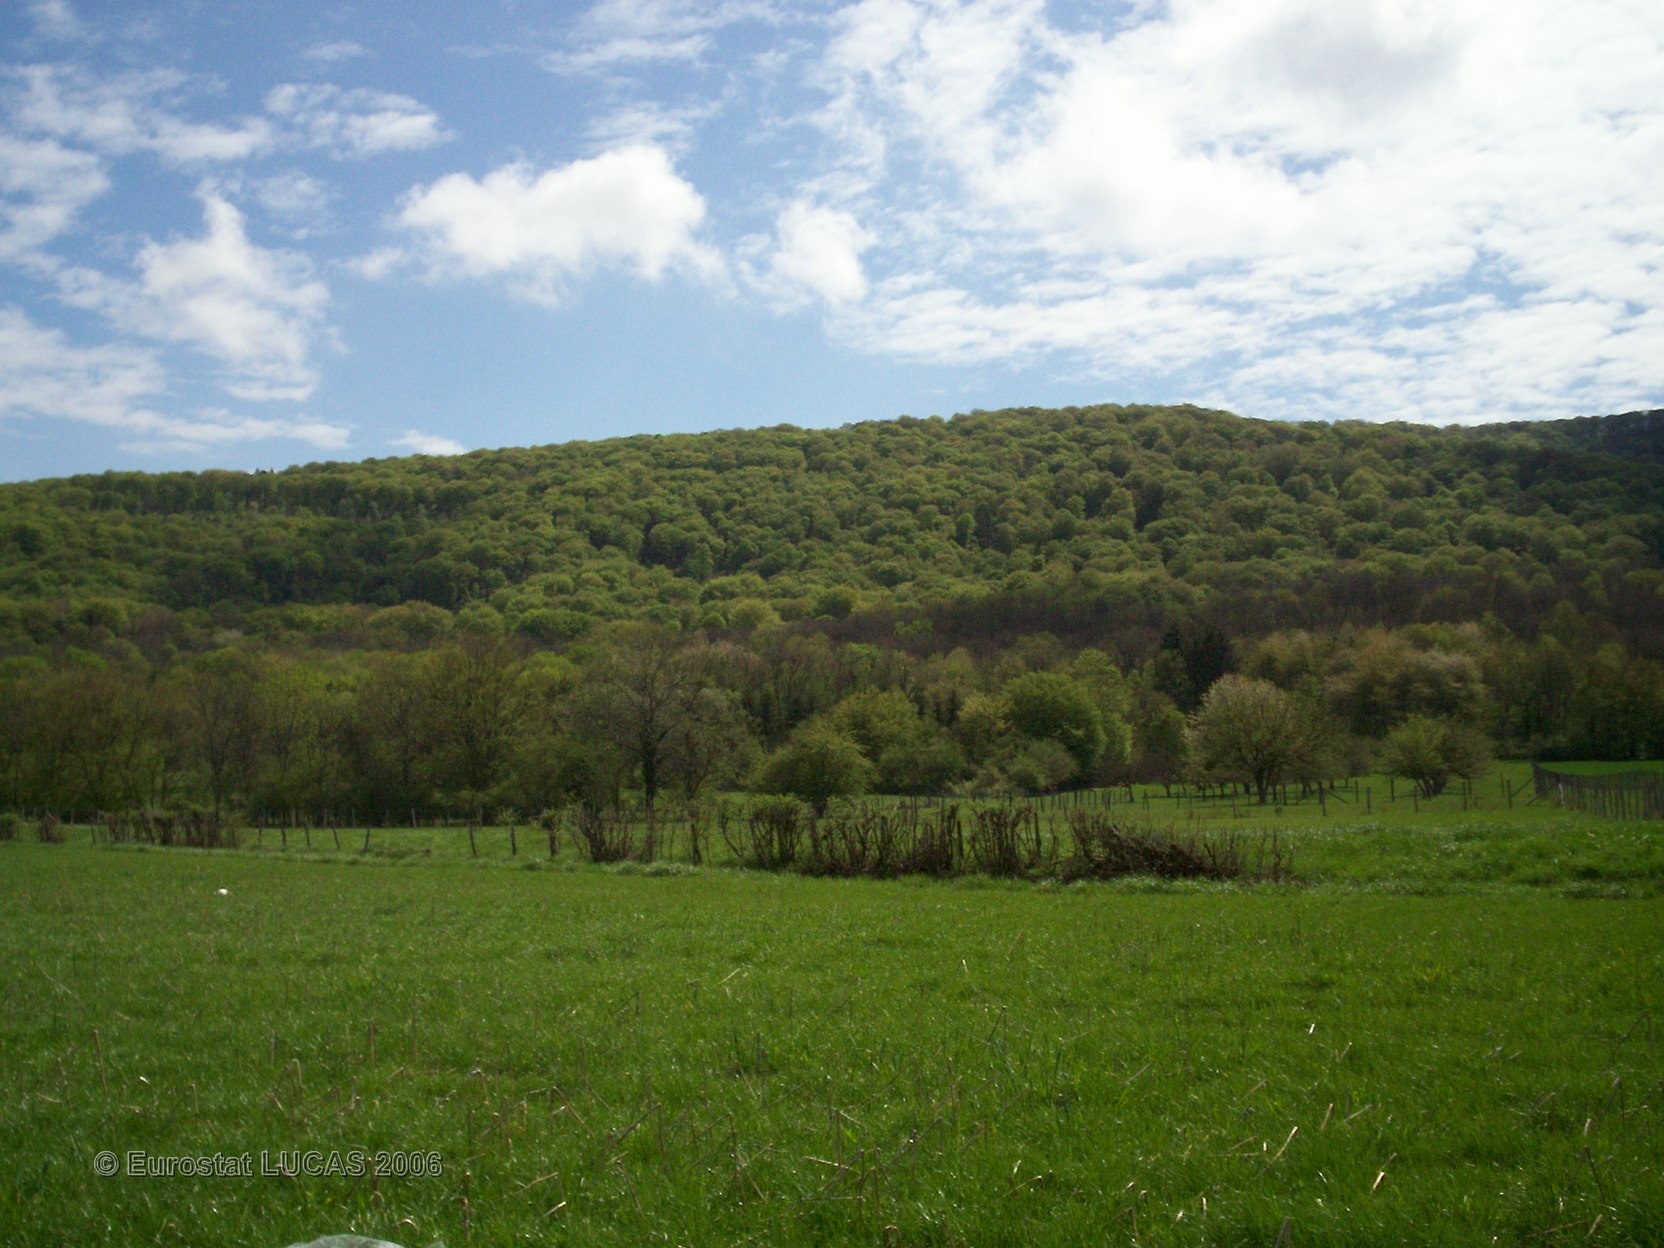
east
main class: Grassland
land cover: Grassland without tree/shrub cover
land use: Fallow land
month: April
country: FR
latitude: 47.3436
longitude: 6.0970
